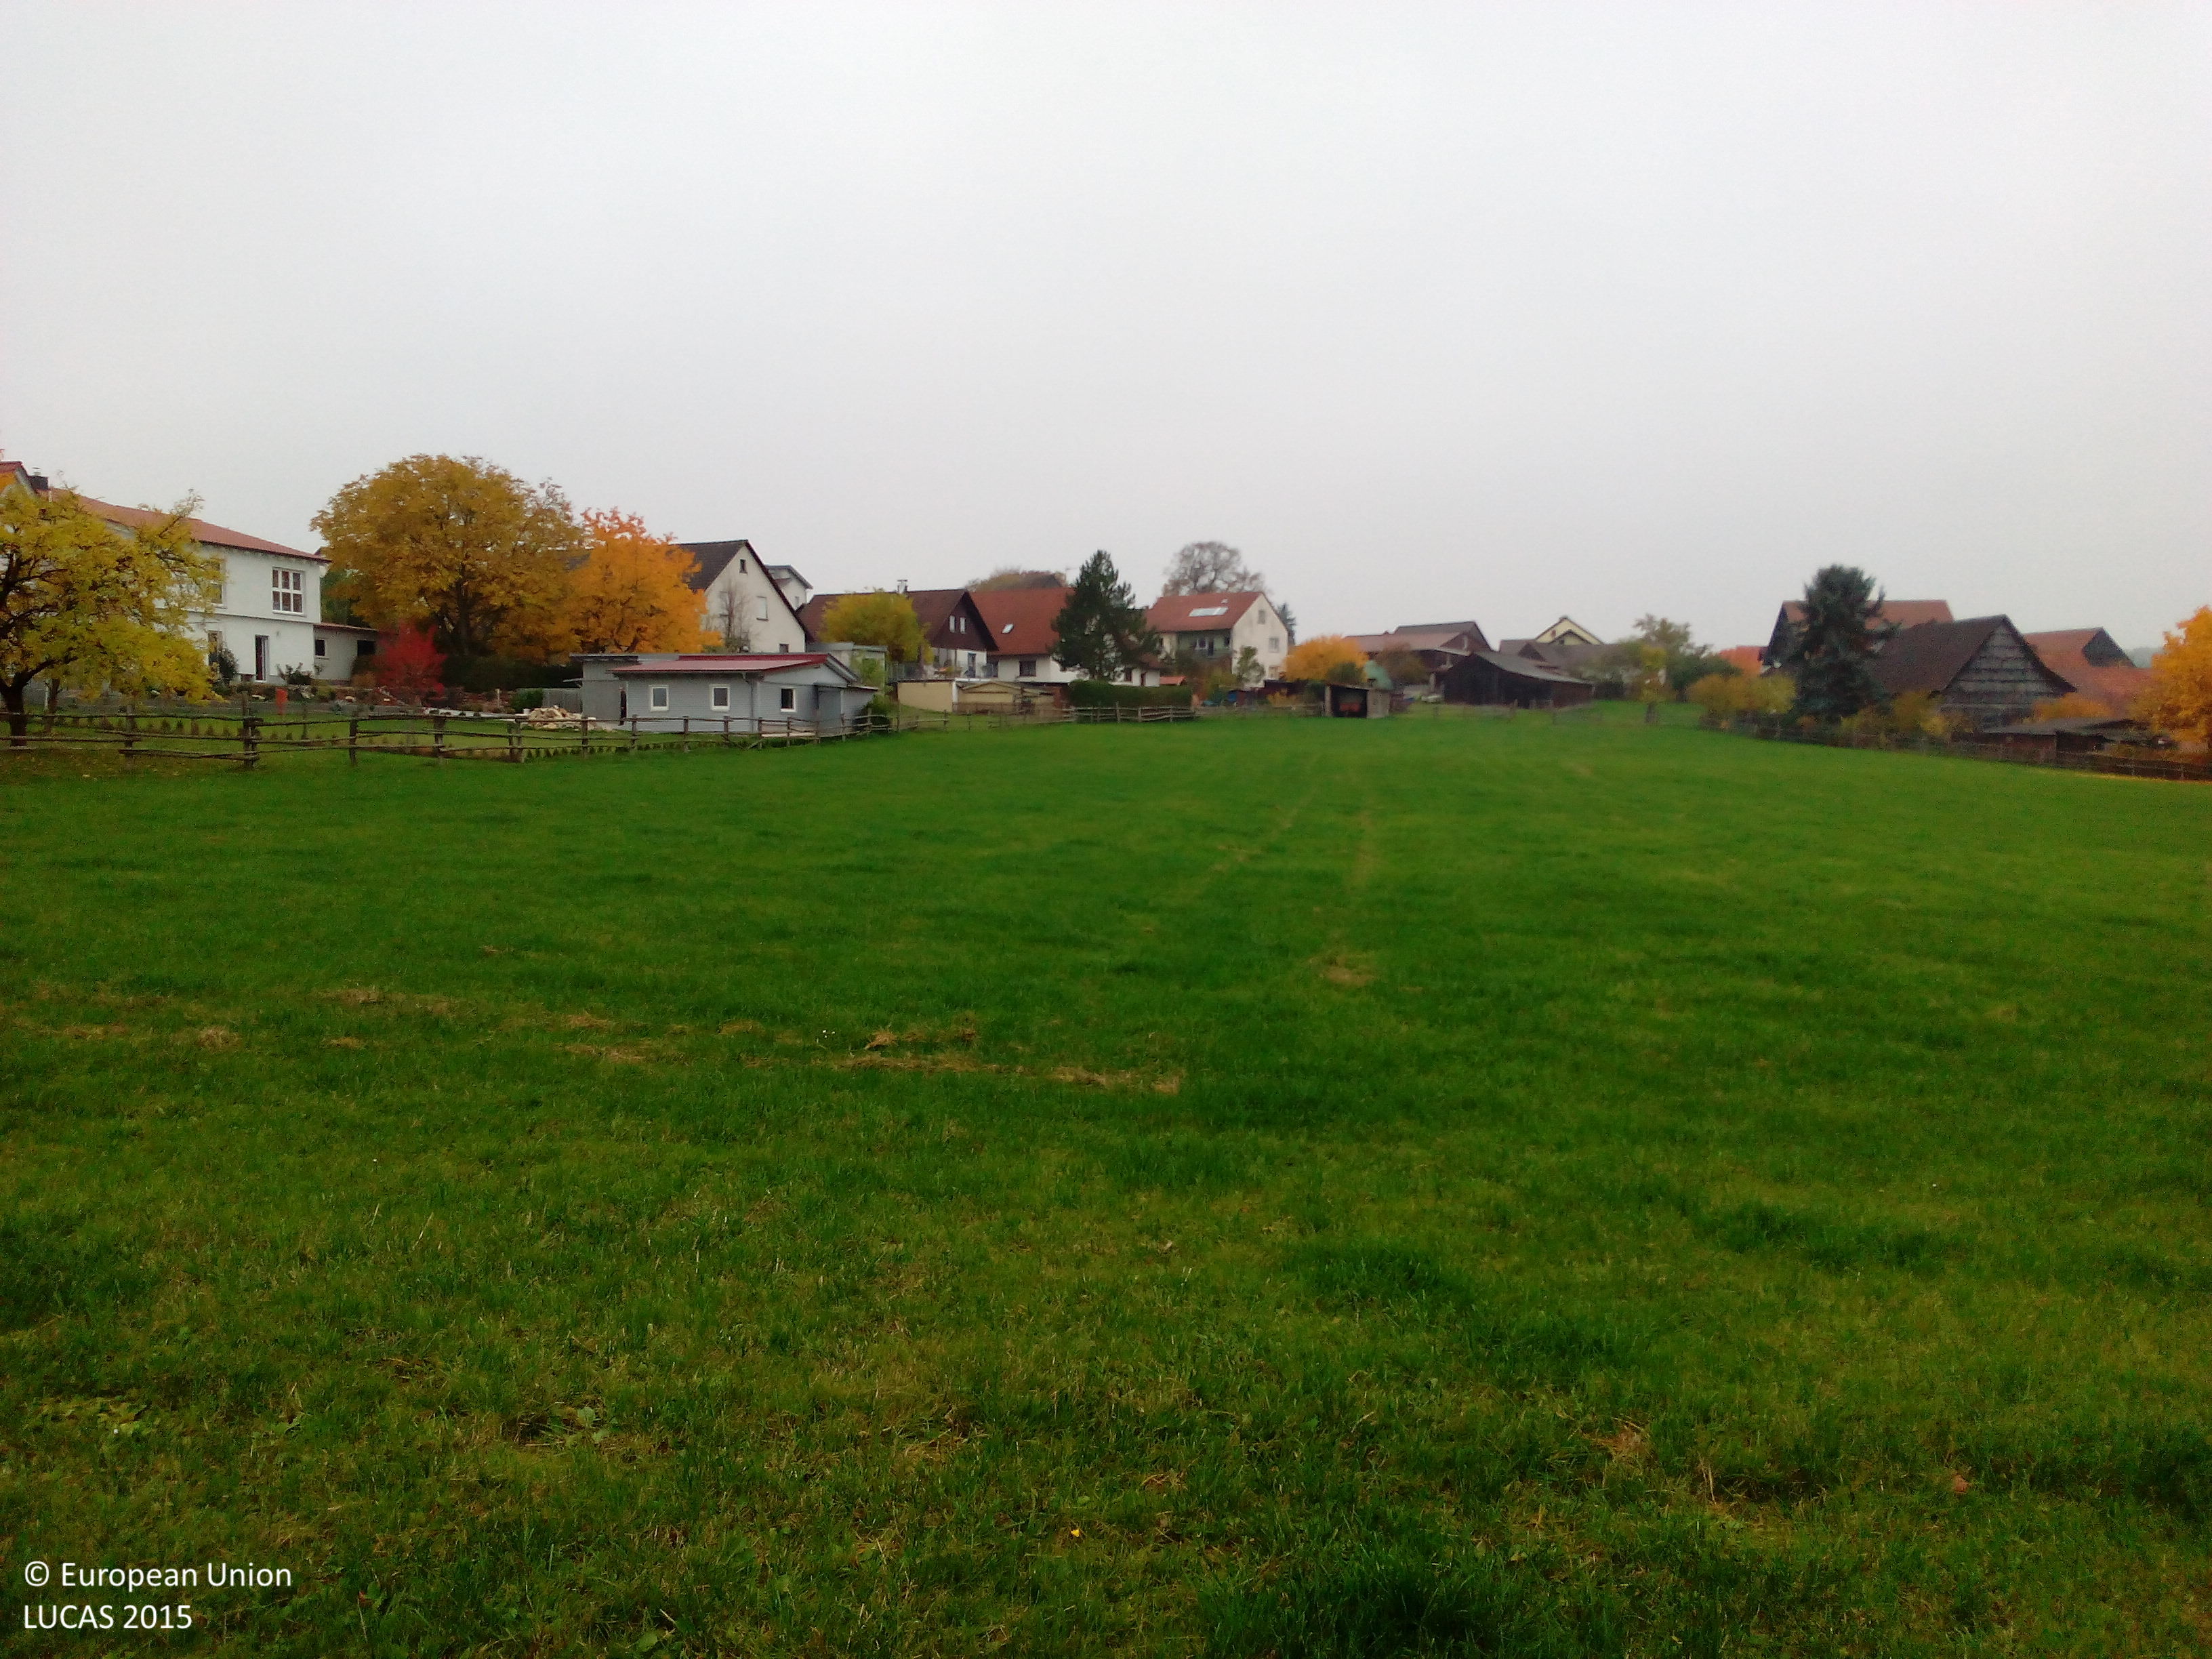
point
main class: Grassland
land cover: Grassland without tree/shrub cover
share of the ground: > 75 %
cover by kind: herbaceous plants 100 %
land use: Agriculture (excluding fallow land and kitchen gardens)
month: October
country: DE
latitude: 50.1842
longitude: 9.8740
